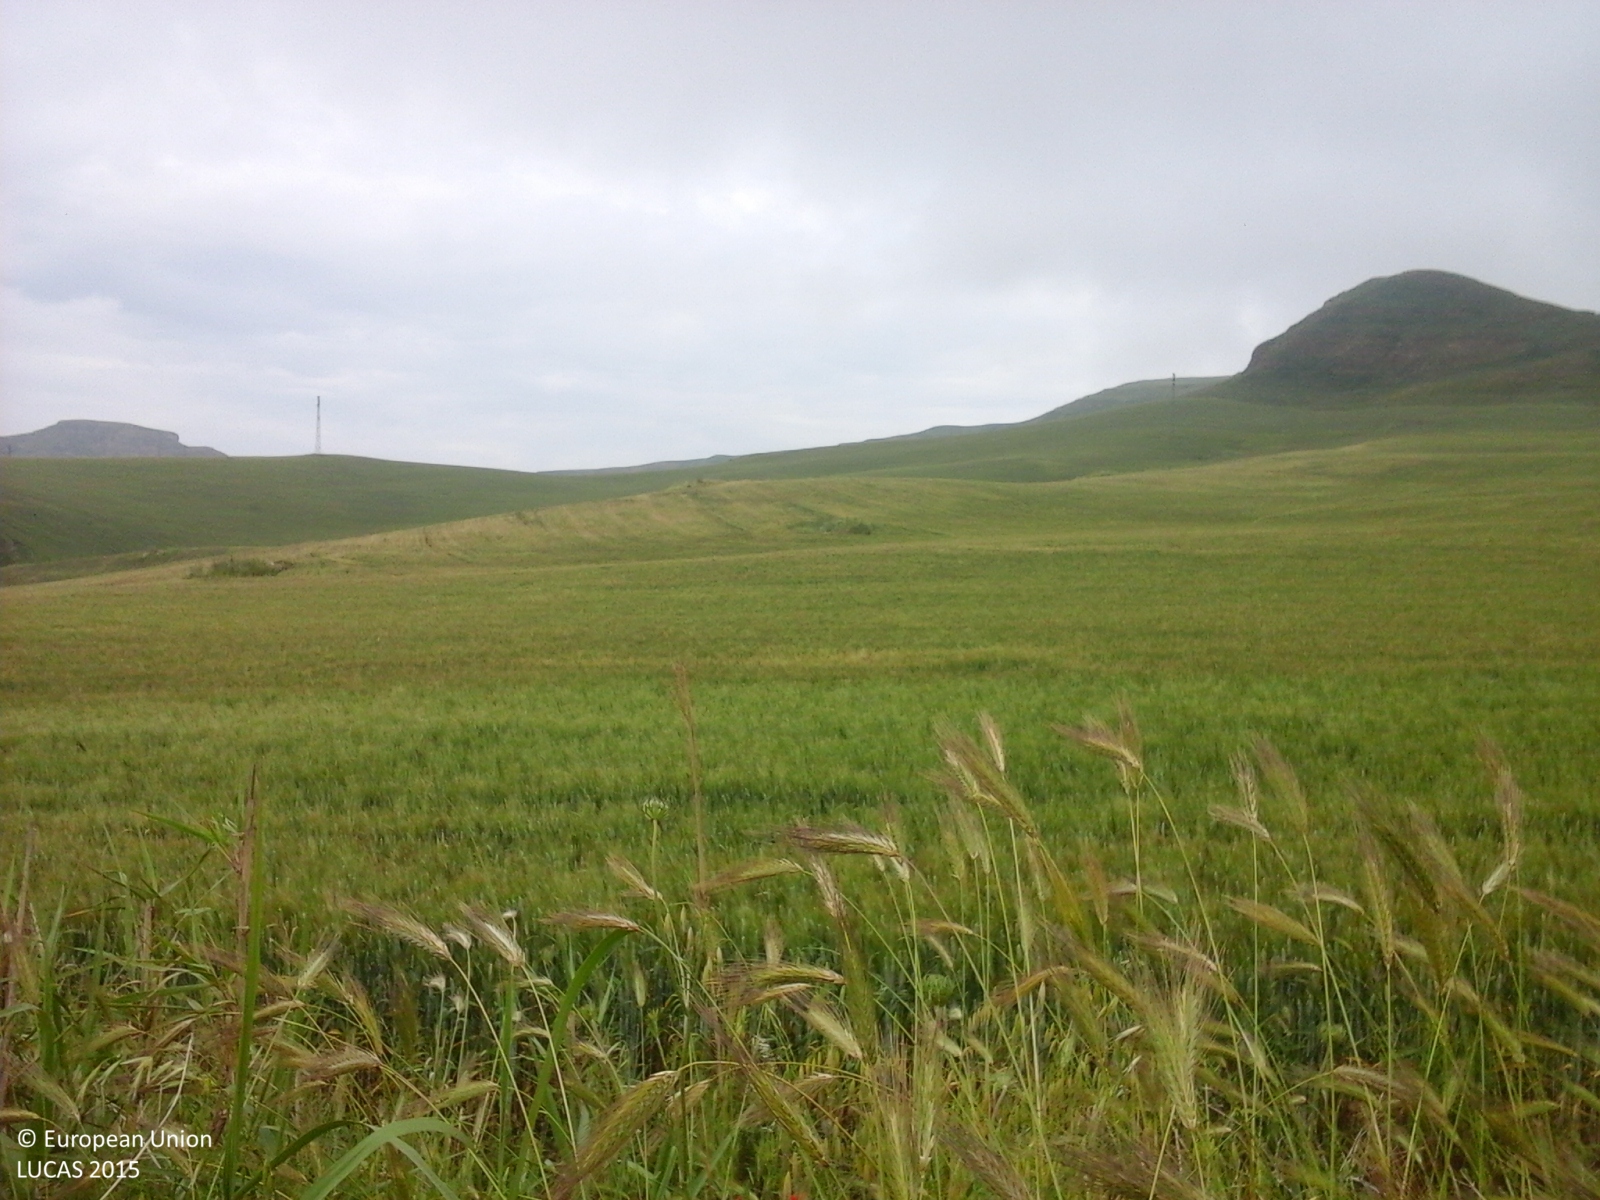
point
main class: Cropland
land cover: Durum wheat
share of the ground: > 75 %
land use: Agriculture (excluding fallow land and kitchen gardens)
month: May
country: IT
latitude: 37.7180
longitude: 13.9983
